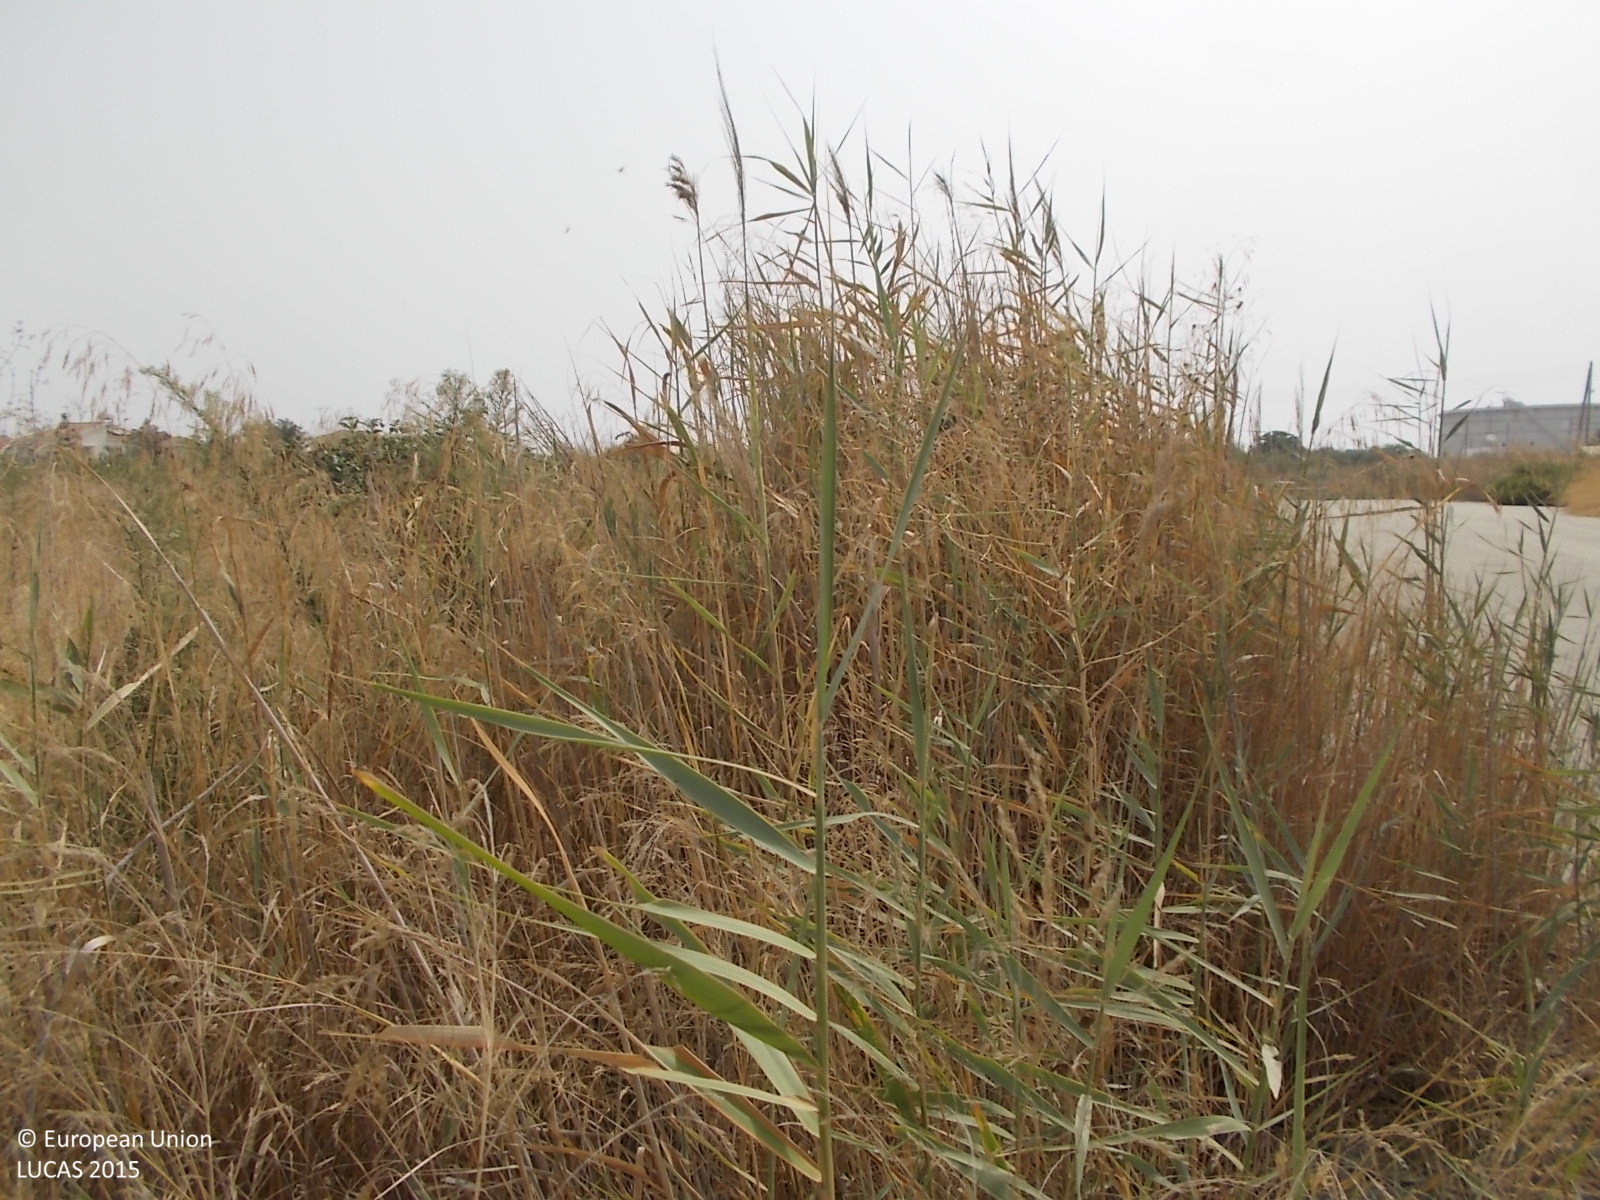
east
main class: Grassland
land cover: Spontaneously vegetated surfaces
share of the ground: > 75 %
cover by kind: herbaceous plants 100 %
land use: Abandoned areas
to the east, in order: Spontaneously vegetated surfaces; Artificial constructions in urban areas; Spontaneously vegetated surfaces; Artificial constructions in urban areas; Other bare soil; Grassland without tree/shrub cover; Fences; Olive groves; Grassland without tree/shrub cover; Other bare soil; Spontaneously vegetated surfaces; Other bare soil
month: April
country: CY
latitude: 34.9468
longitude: 33.6412
